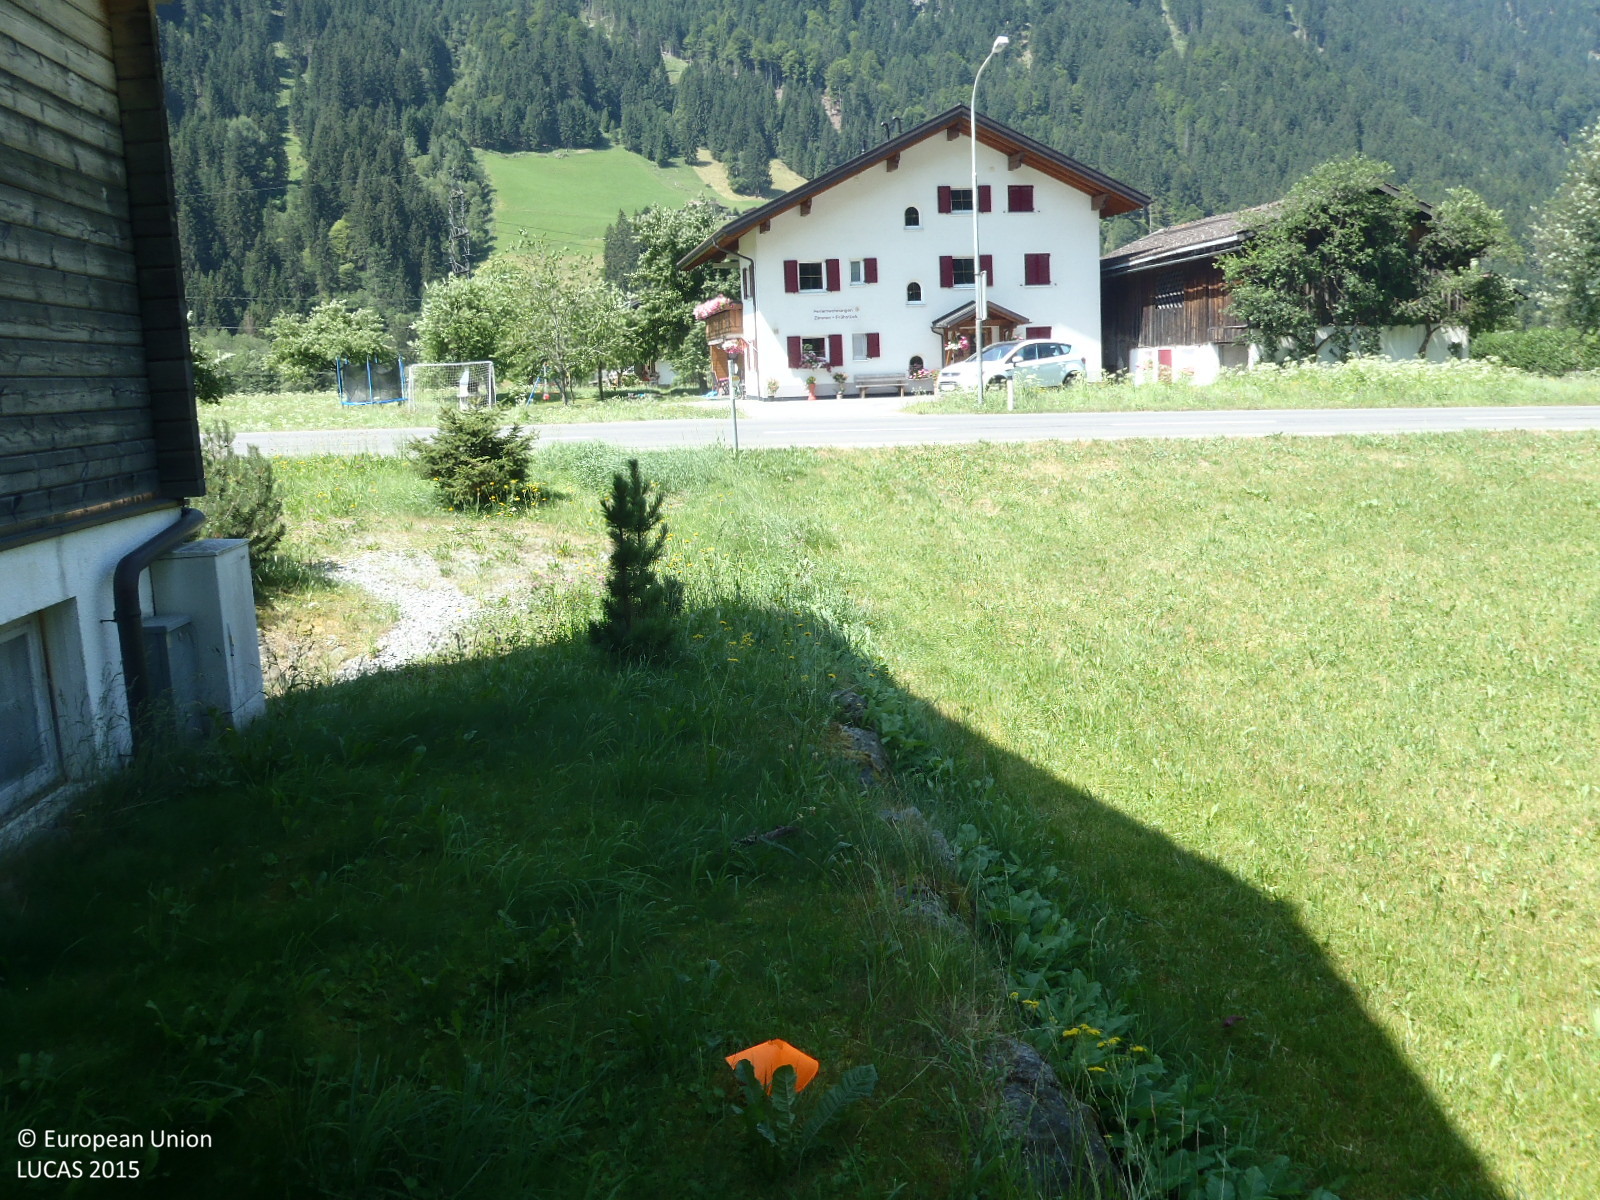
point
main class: Grassland
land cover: Grassland without tree/shrub cover
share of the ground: > 75 %
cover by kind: herbaceous plants 100 %
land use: Residential
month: July
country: AT
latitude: 46.9995
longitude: 10.0131
